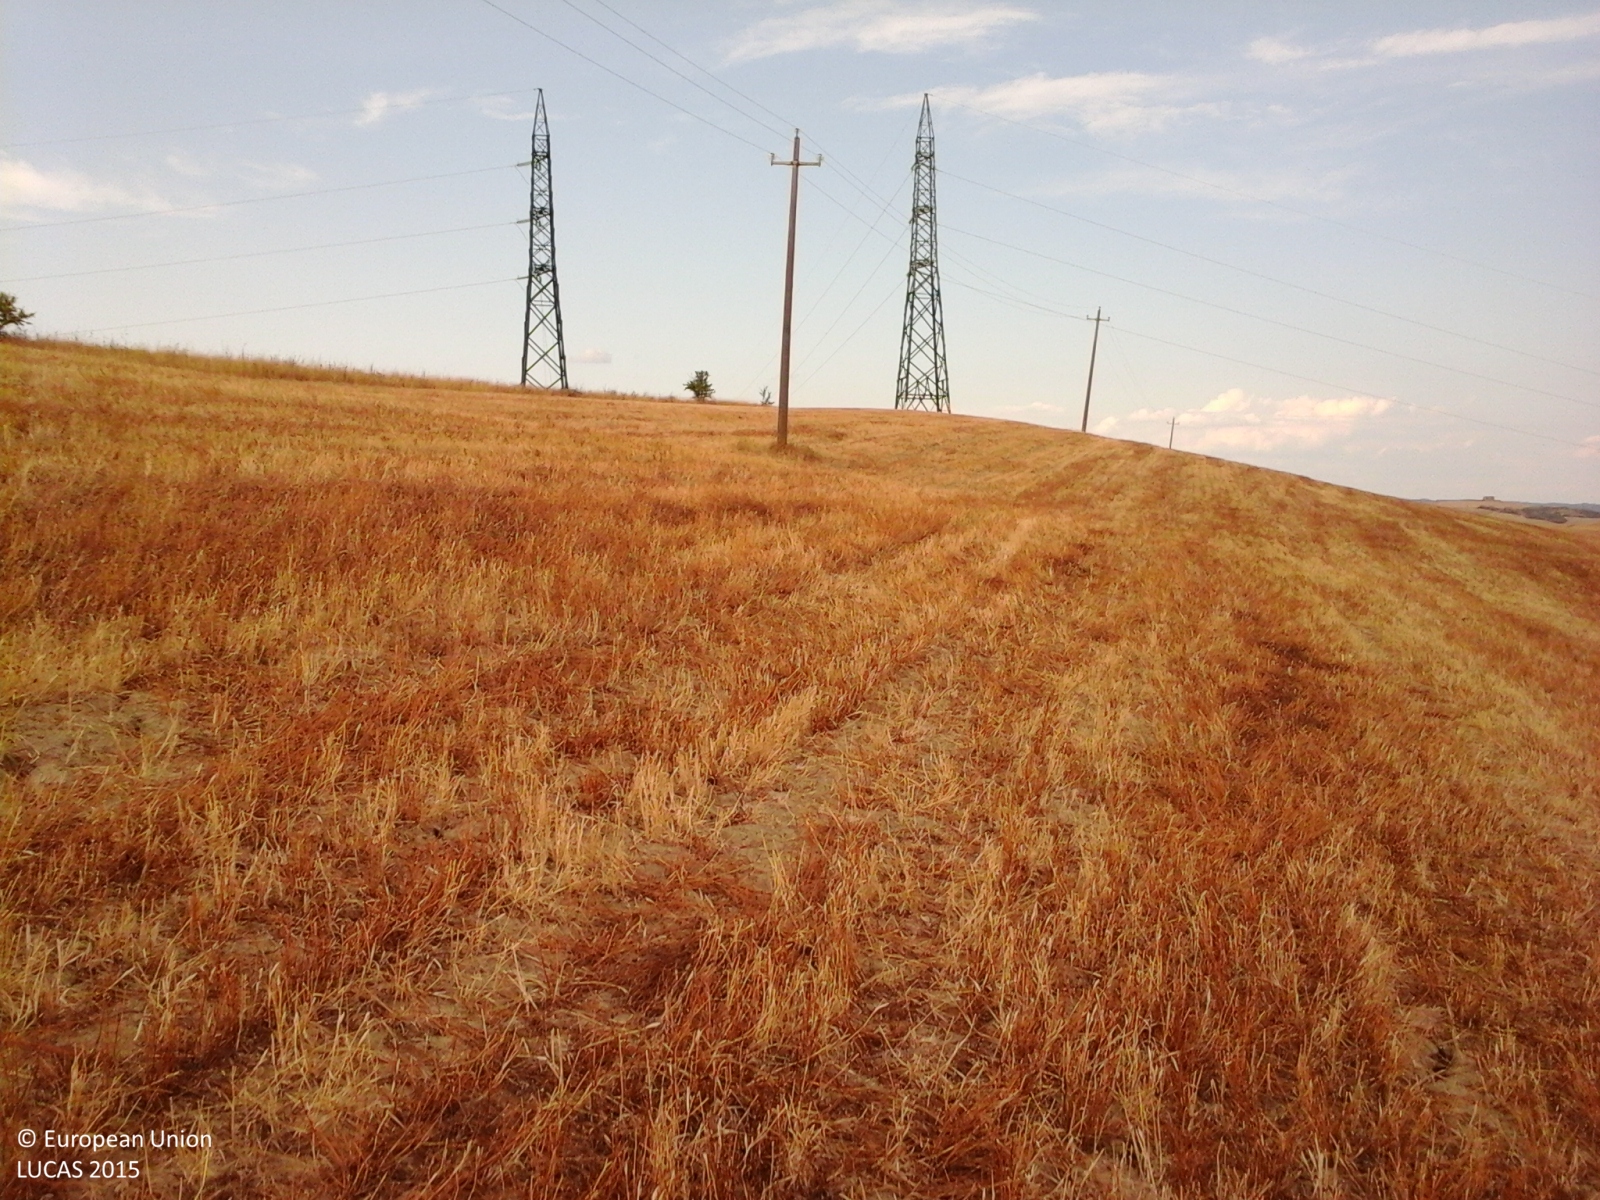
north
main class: Cropland
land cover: Temporary grasslands
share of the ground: > 75 %
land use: Agriculture (excluding fallow land and kitchen gardens)
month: July
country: IT
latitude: 43.0579
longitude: 11.5301
